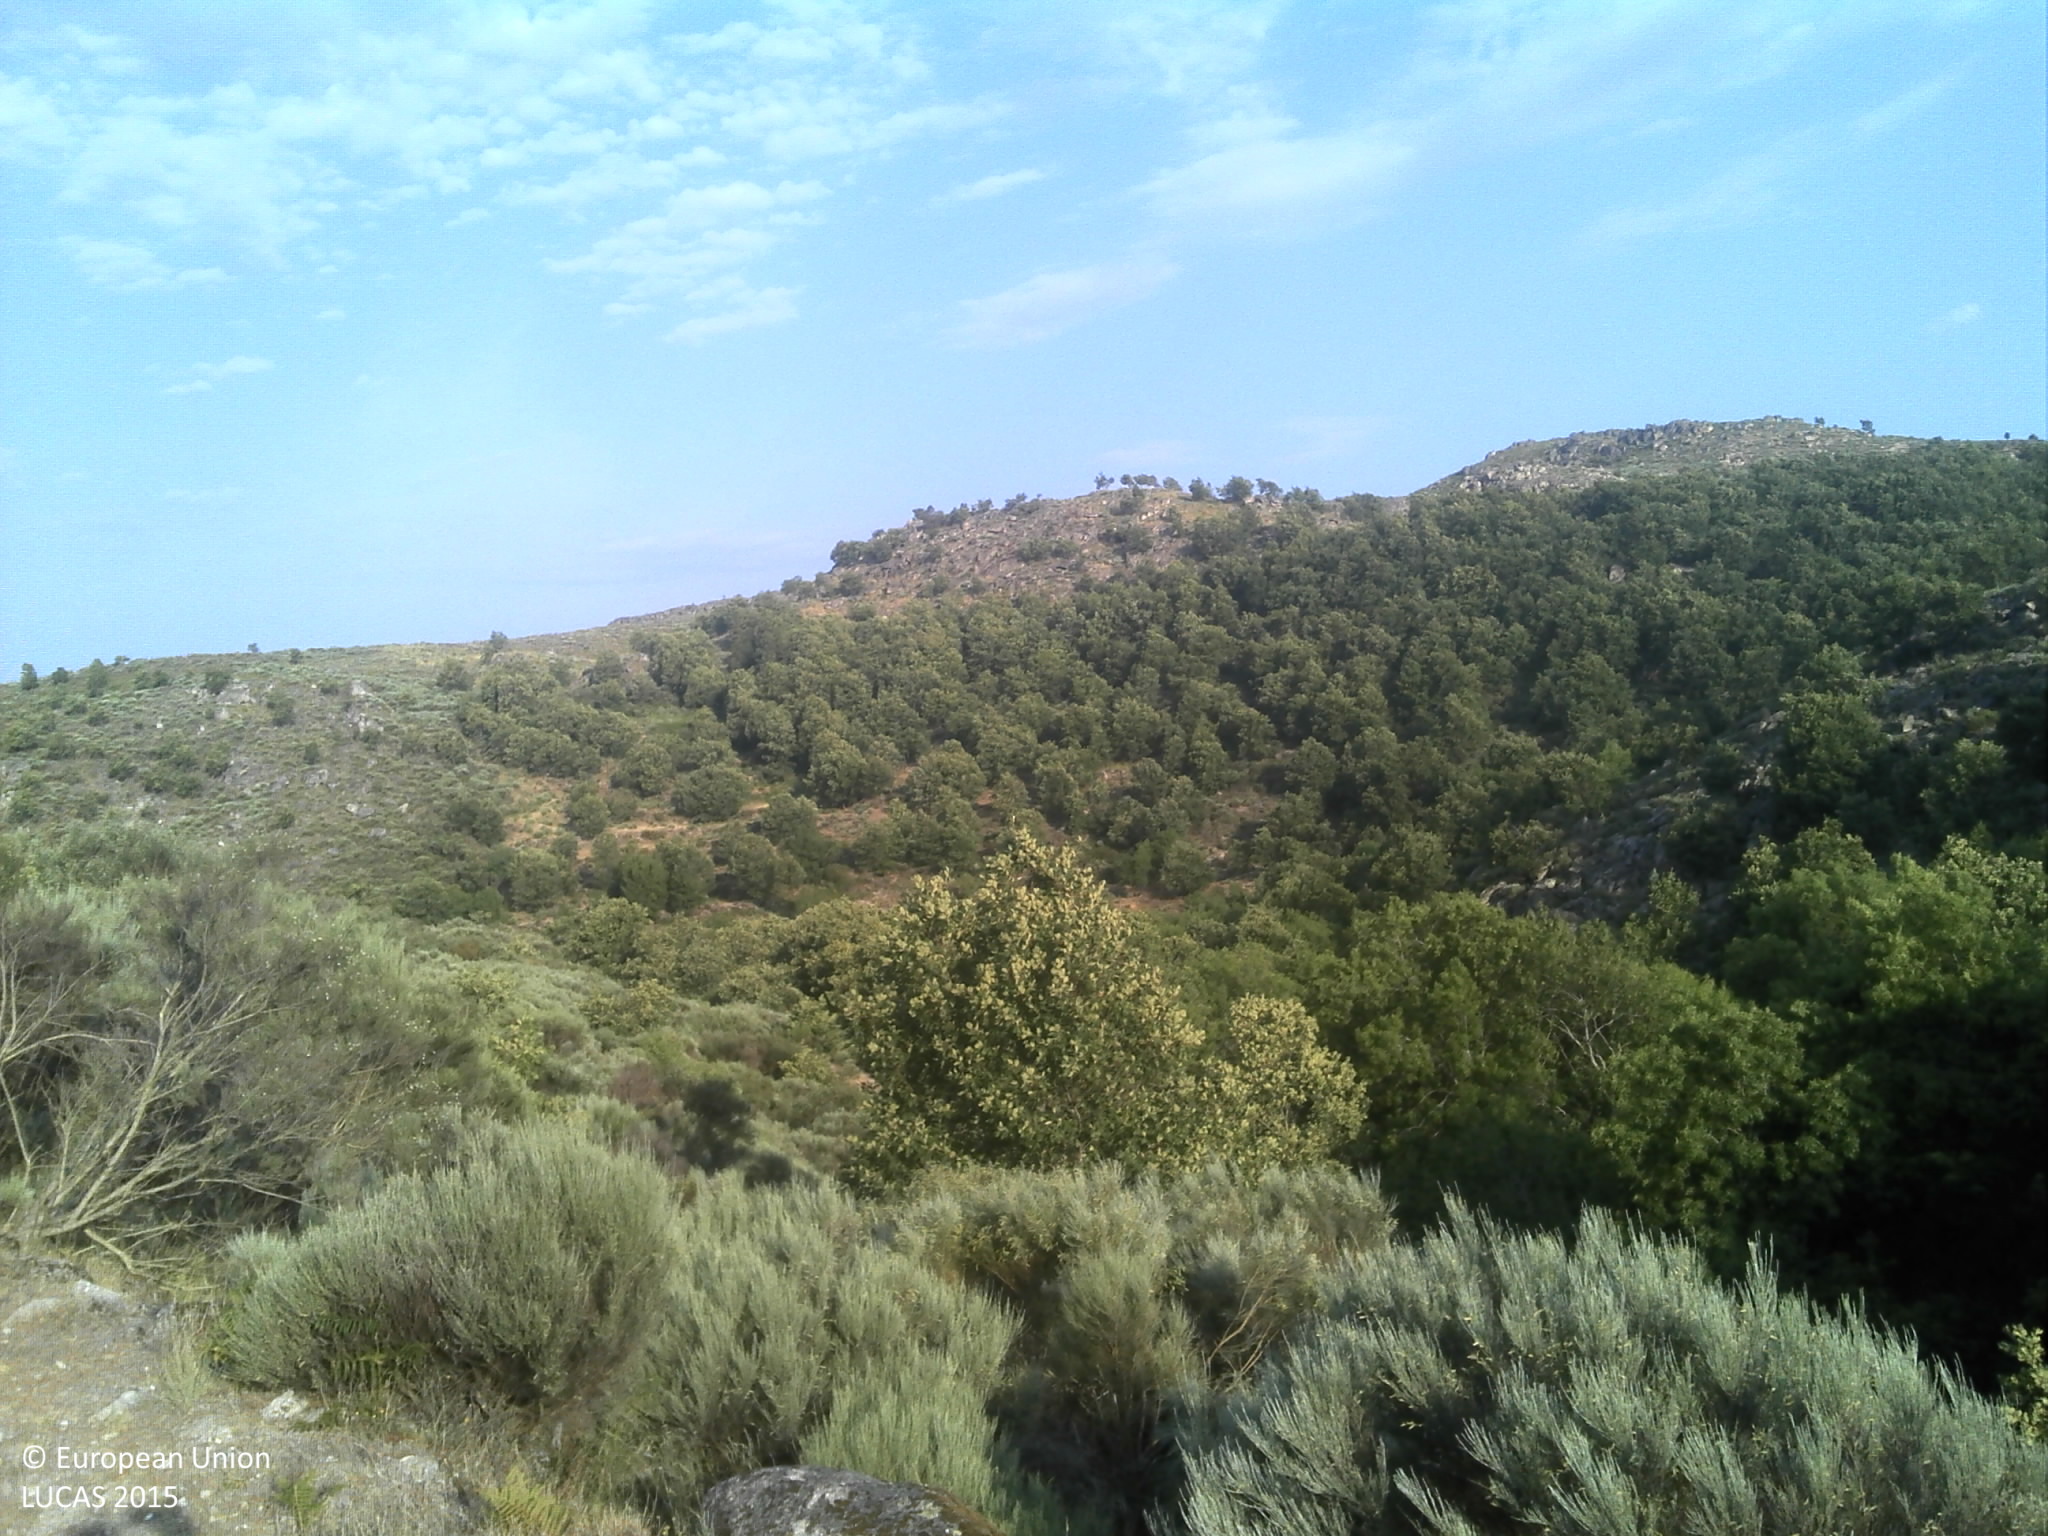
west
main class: Shrubland
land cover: Shrubland without tree cover
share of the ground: 25 - 50 %
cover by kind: shrubs 40 %, unconsolidated bare surface 20 %, herbaceous plants 15 %, consolidated bare surface 15 %
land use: Semi-natural and natural areas not in use
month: June
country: PT
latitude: 40.3784
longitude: -7.1920
